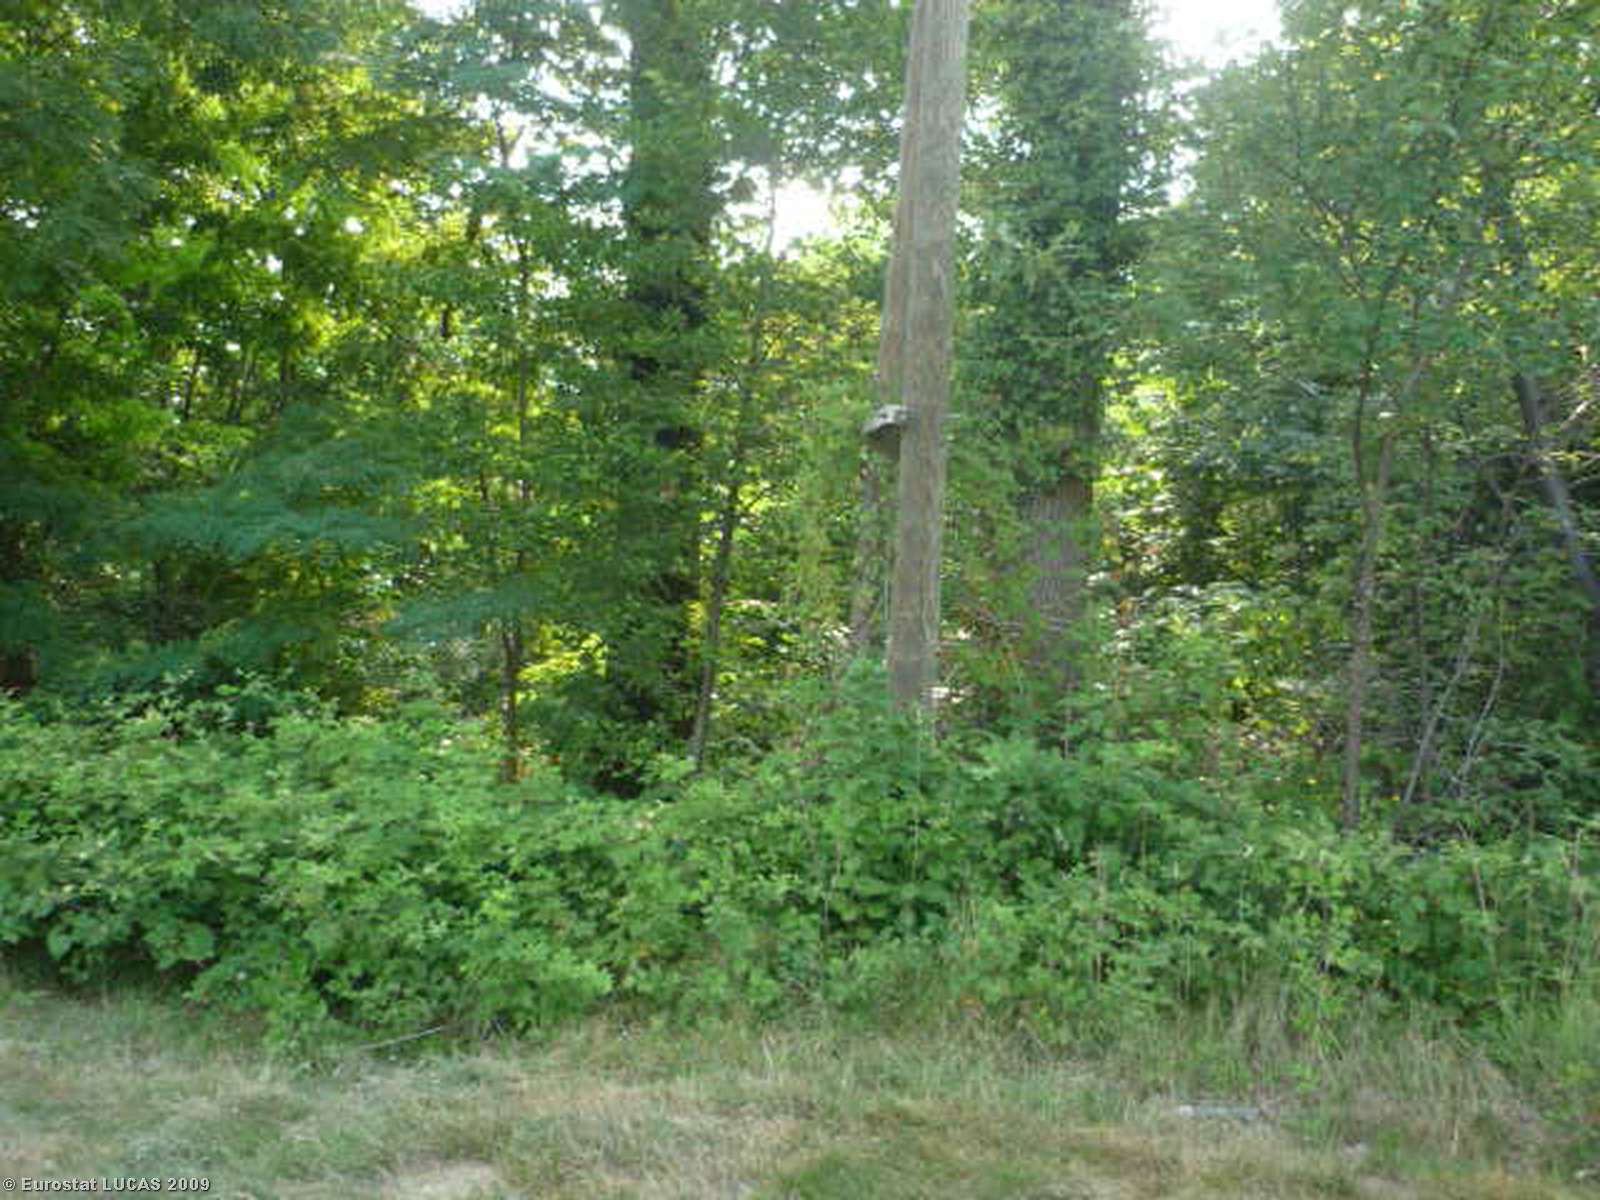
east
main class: Woodland
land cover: Broadleaved woodland
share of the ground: > 75 %
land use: Forestry
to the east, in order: Broadleaved woodland; Grassland without tree/shrub cover; Broadleaved woodland; Grassland without tree/shrub cover; Grass margins; Maize; Abandoned hedges; Ditches and canals; Abandoned hedges; Common wheat; Maize
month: July
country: IT
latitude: 45.4868
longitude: 8.0711
